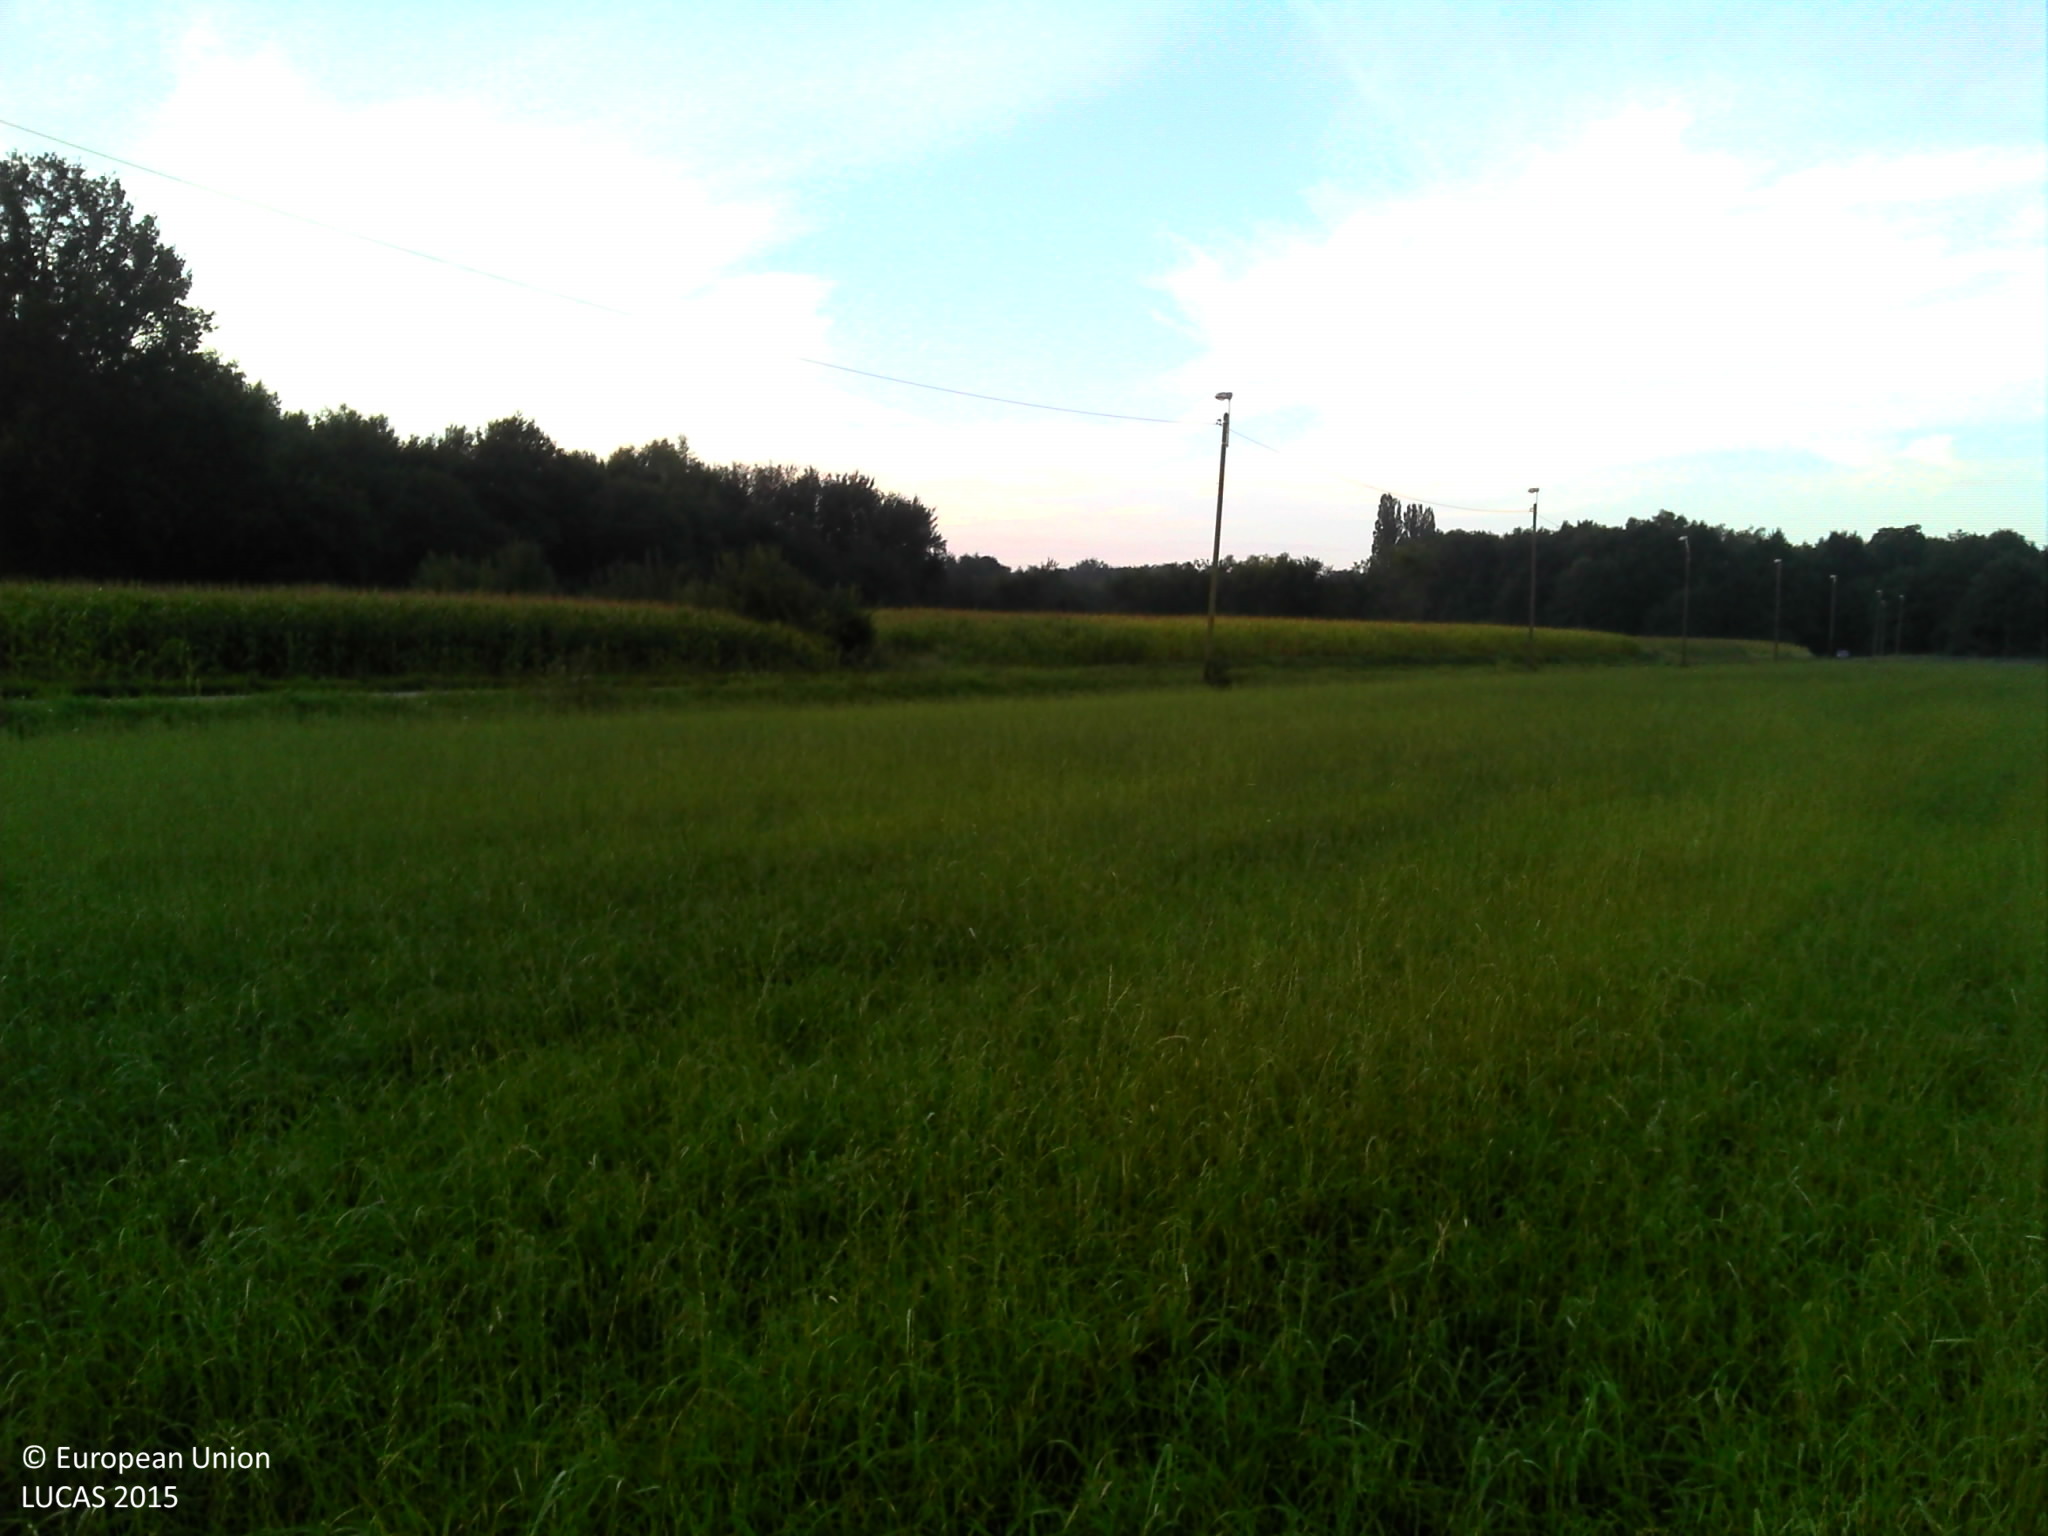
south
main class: Cropland
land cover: Temporary grasslands
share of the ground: > 75 %
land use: Agriculture (excluding fallow land and kitchen gardens)
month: September
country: BE
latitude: 51.0499
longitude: 4.2748
